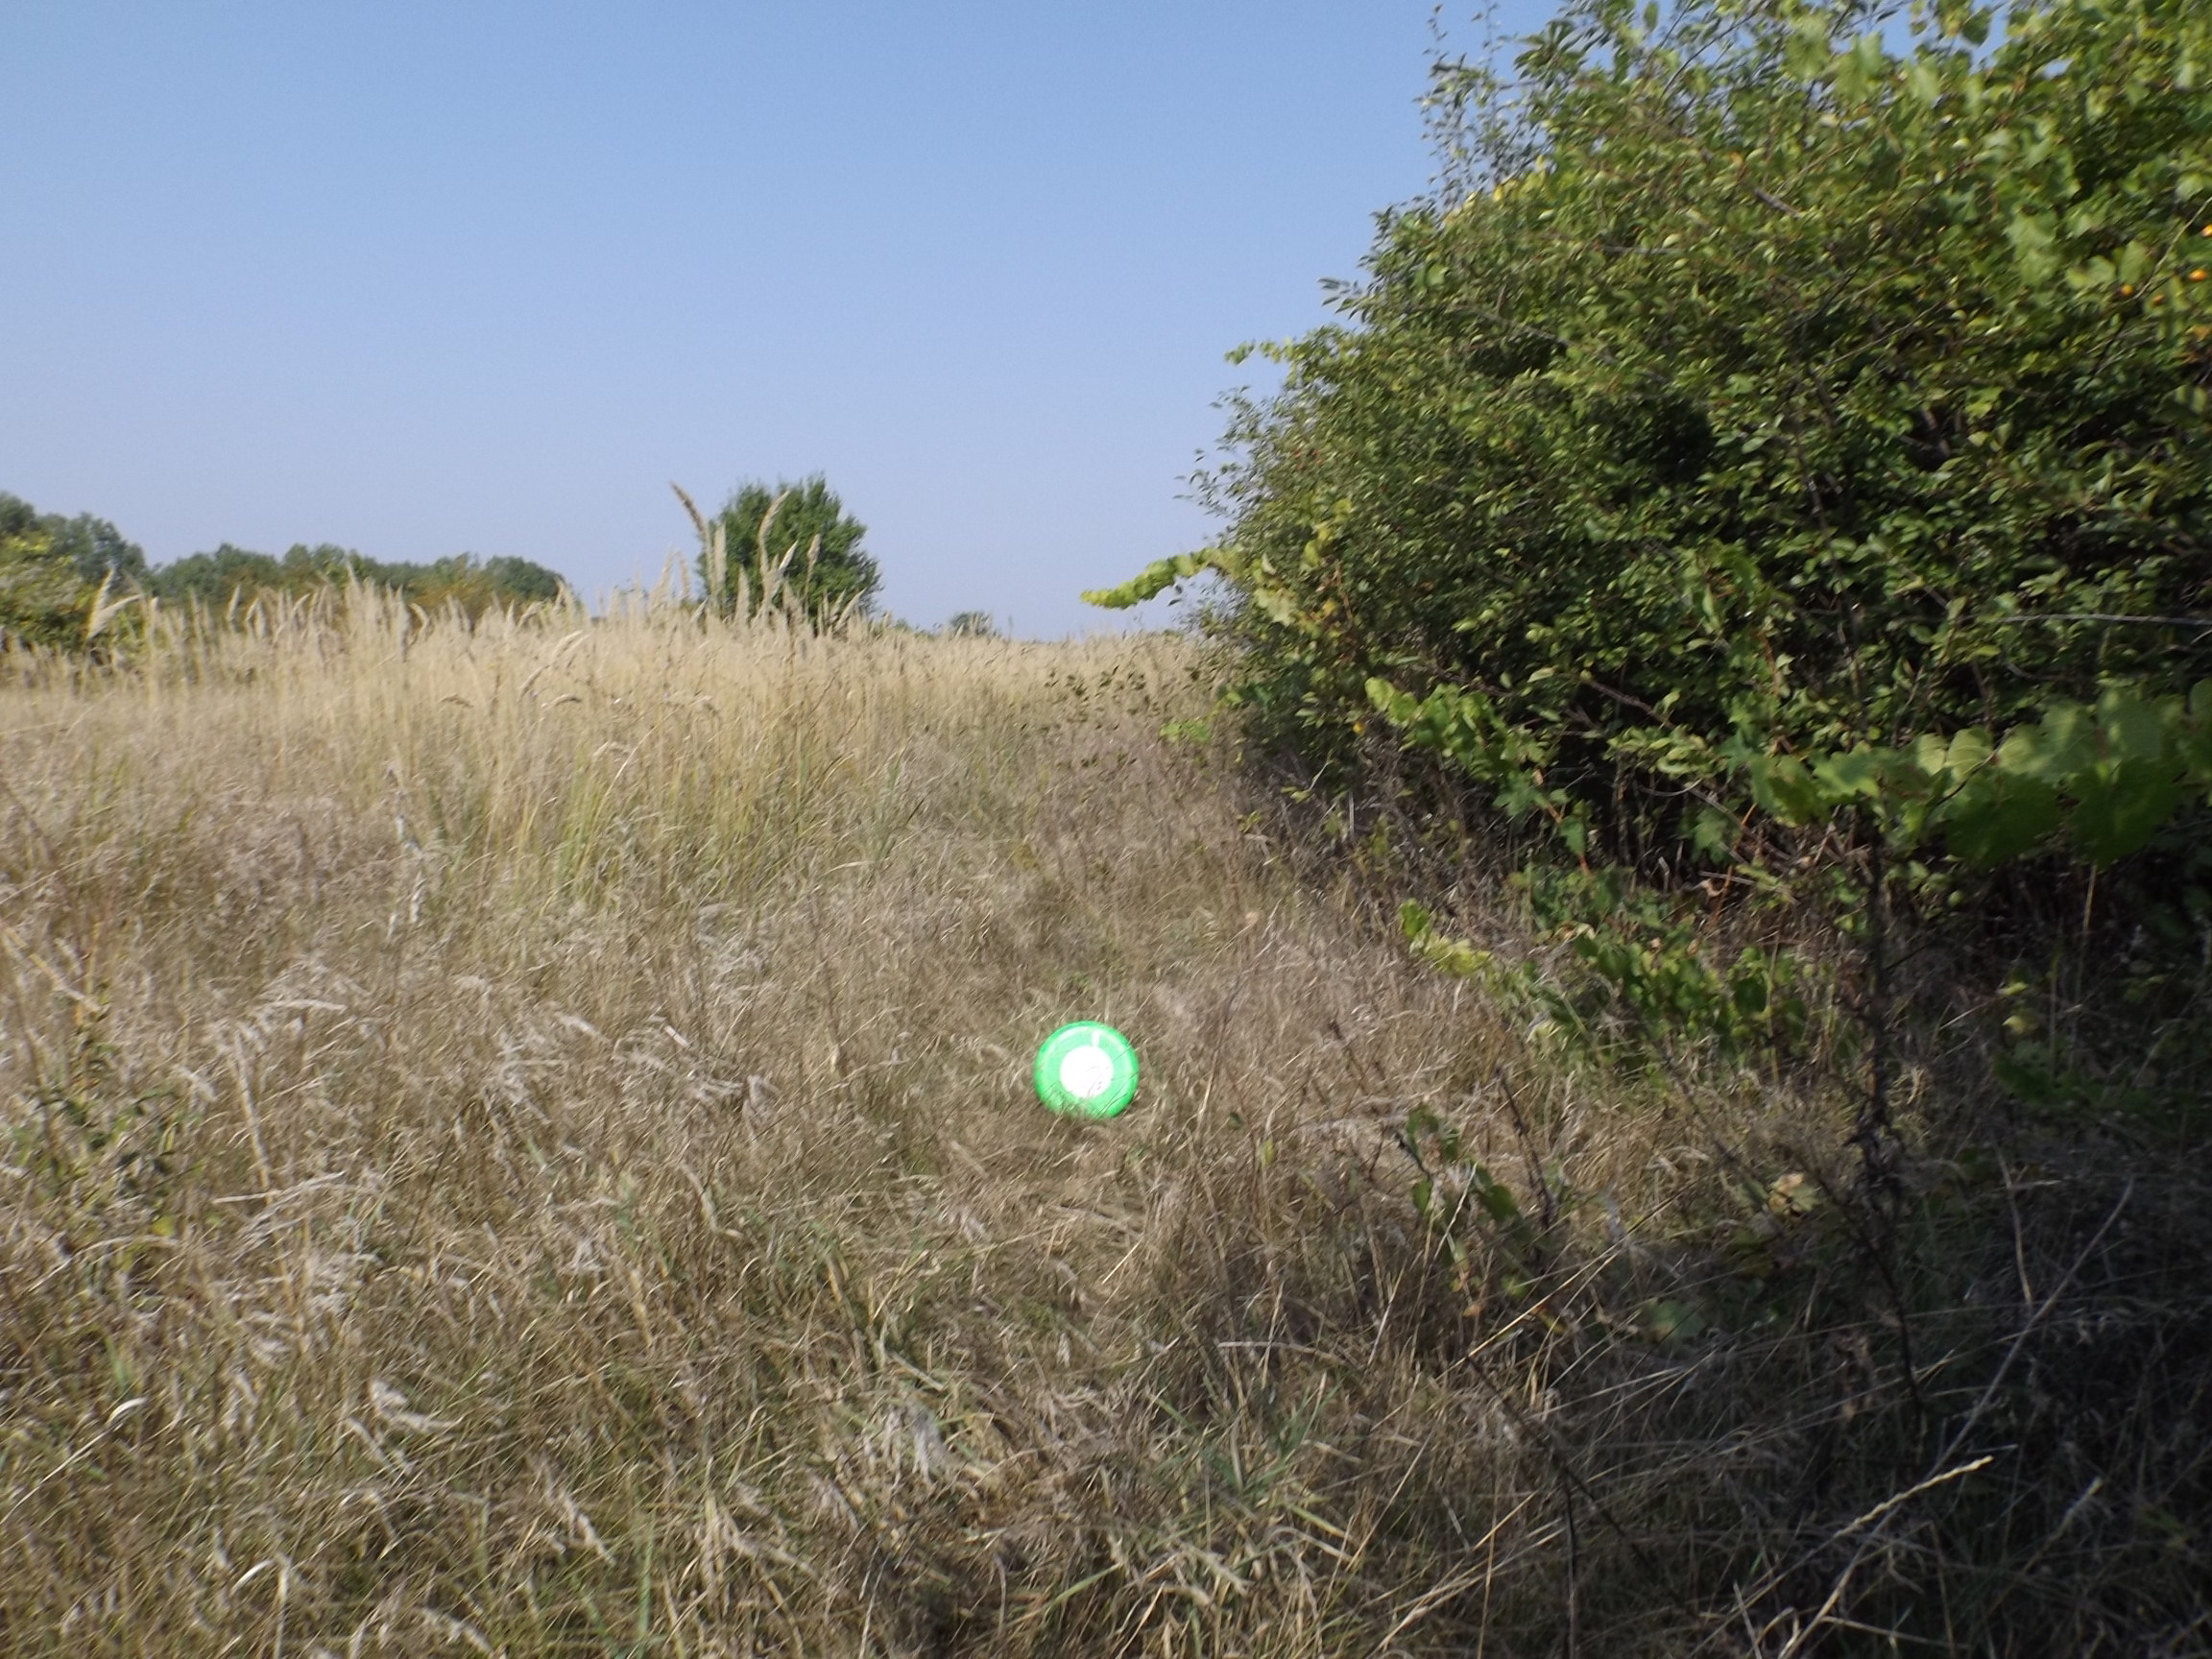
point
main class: Shrubland
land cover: Shrubland with sparse tree cover
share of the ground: > 75 %
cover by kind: shrubs 75 %, herbaceous plants 20 %, broadleaved forest trees 5 %
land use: Semi-natural and natural areas not in use
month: August
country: BG
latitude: 43.2164
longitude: 27.2942
